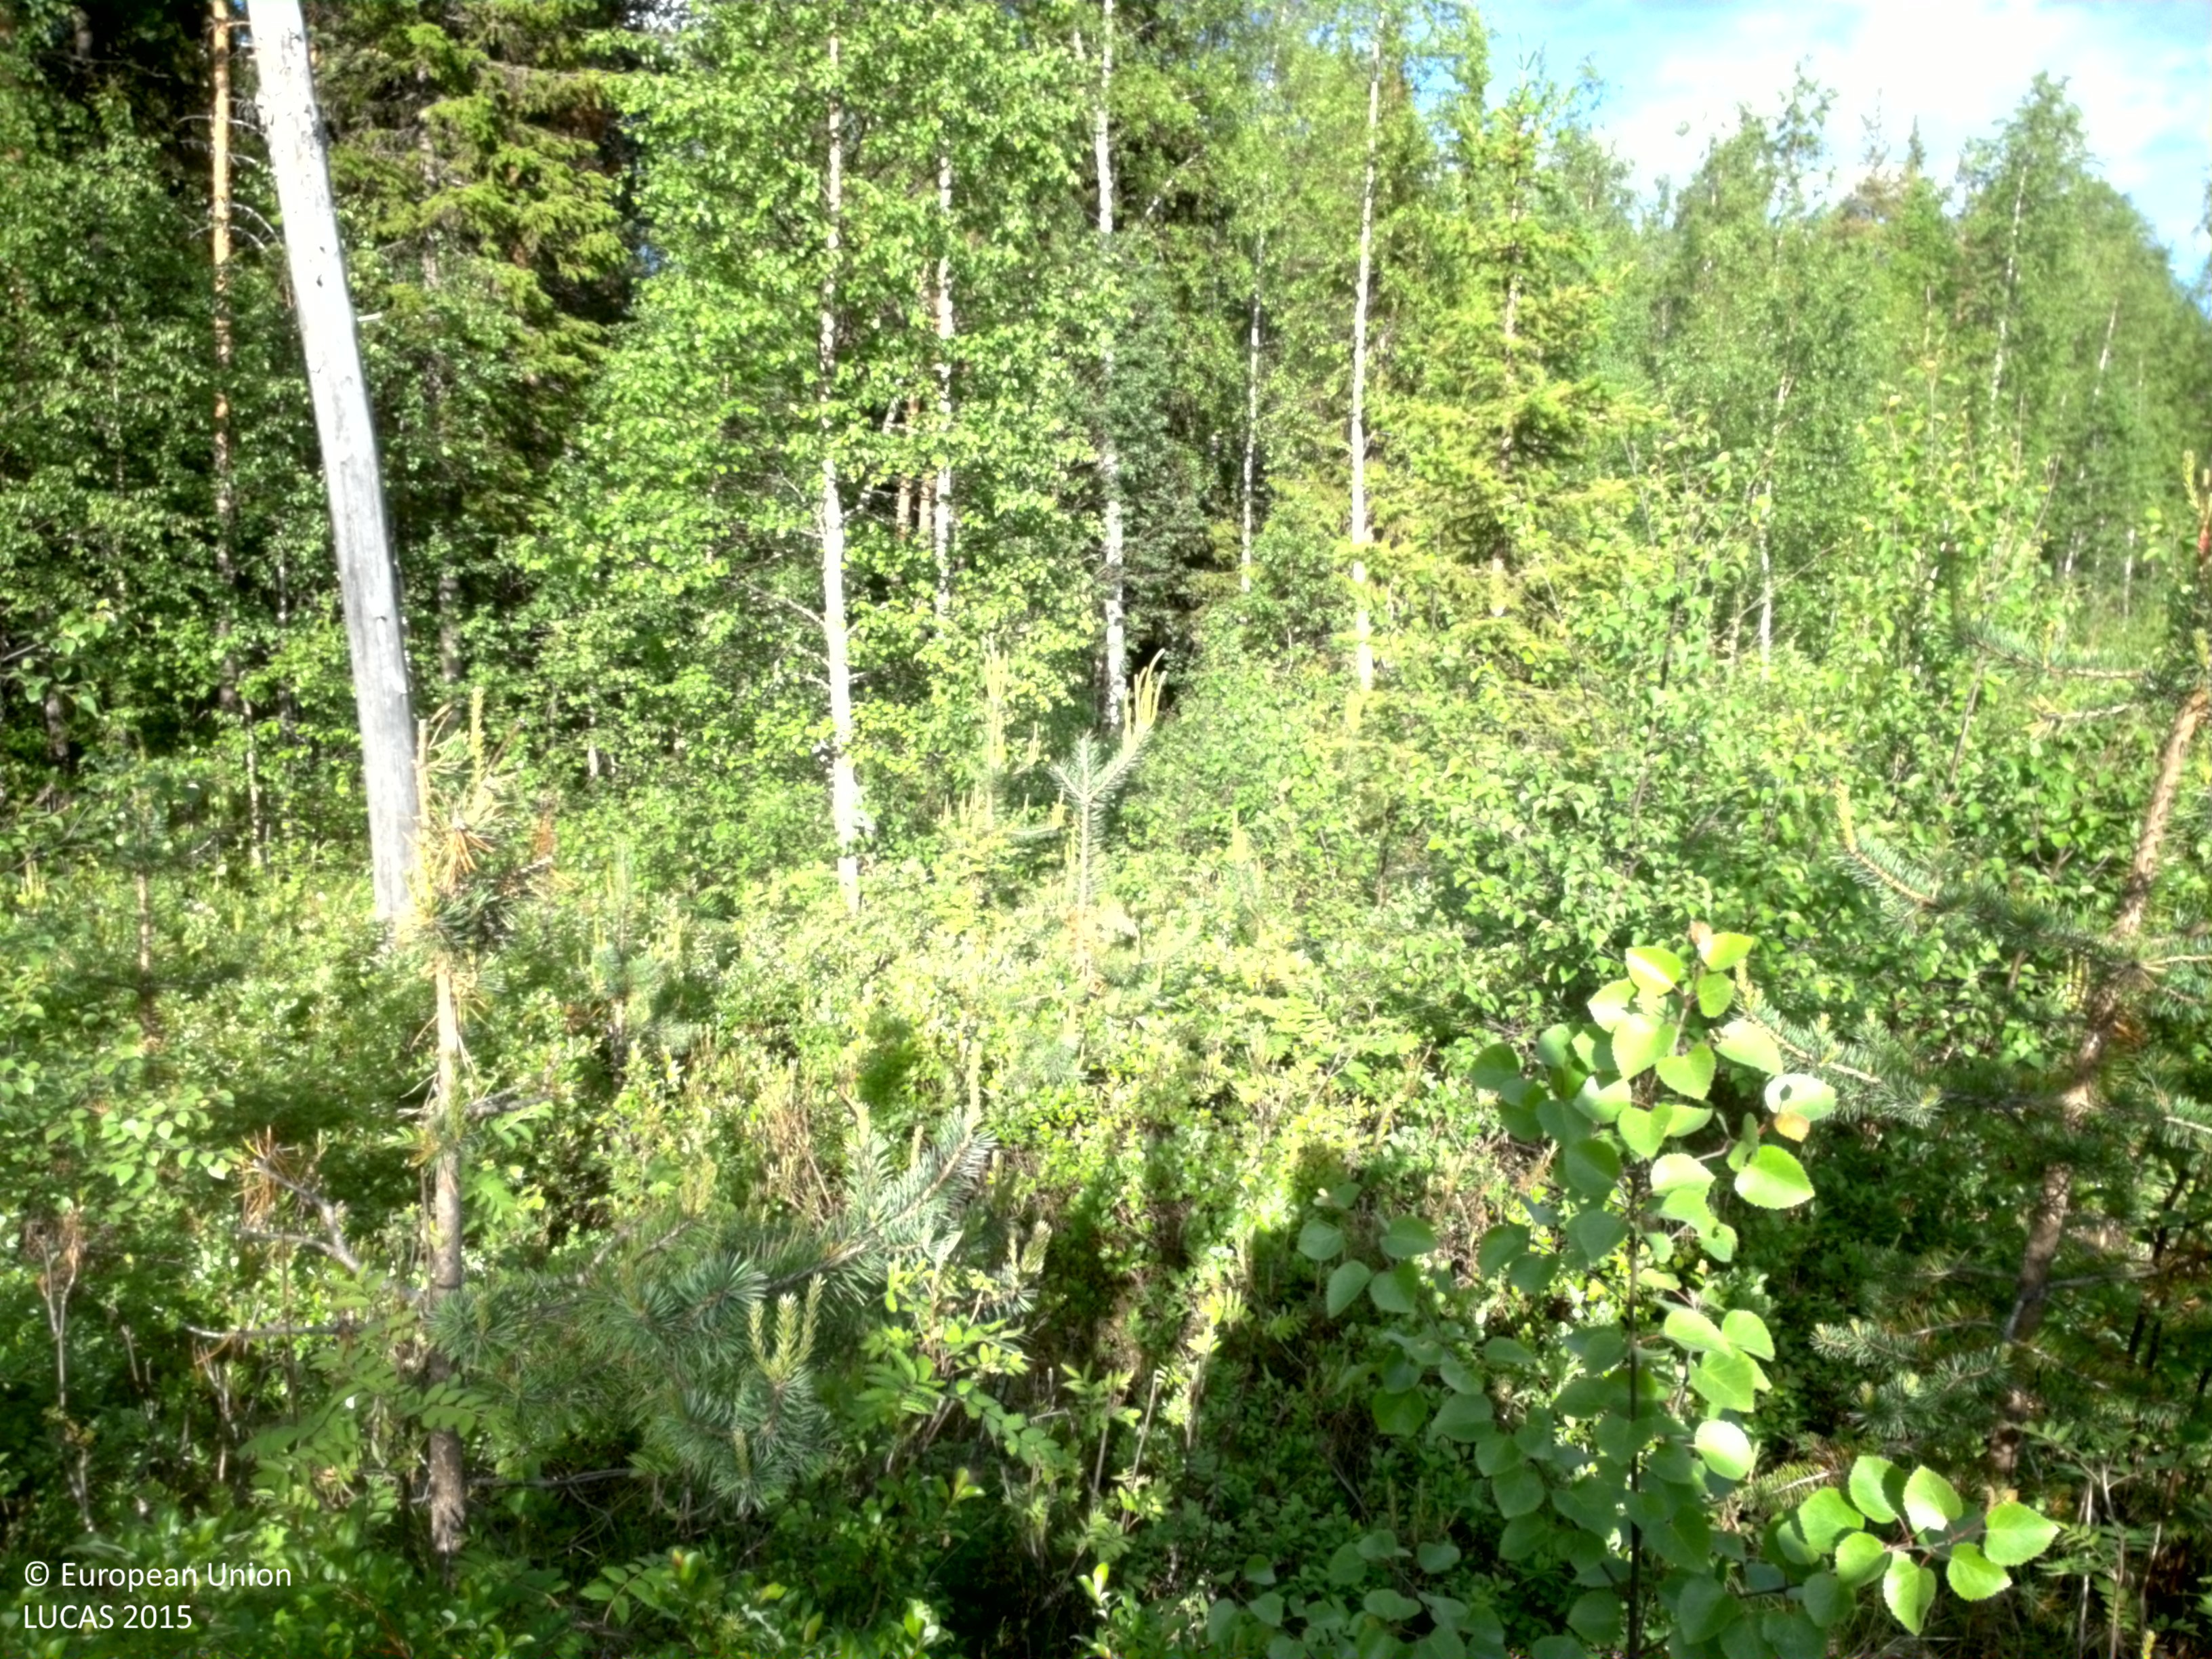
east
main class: Woodland
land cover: Pine dominated mixed woodland
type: boreal forest
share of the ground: 50 - 75 %
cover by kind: broadleaved forest trees 45 %, shrubs 30 %, coniferous forest trees 20 %, lichens and mosses 5 %
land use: Forestry
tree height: < 5 m
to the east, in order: Pine dominated mixed woodland; Broadleaved woodland; Spruce dominated mixed woodland; Broadleaved woodland; Tracks; Broadleaved woodland; Rivers and streams; Broadleaved woodland; Spruce dominated mixed woodland
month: June
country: SE
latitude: 66.3827
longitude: 22.7034
